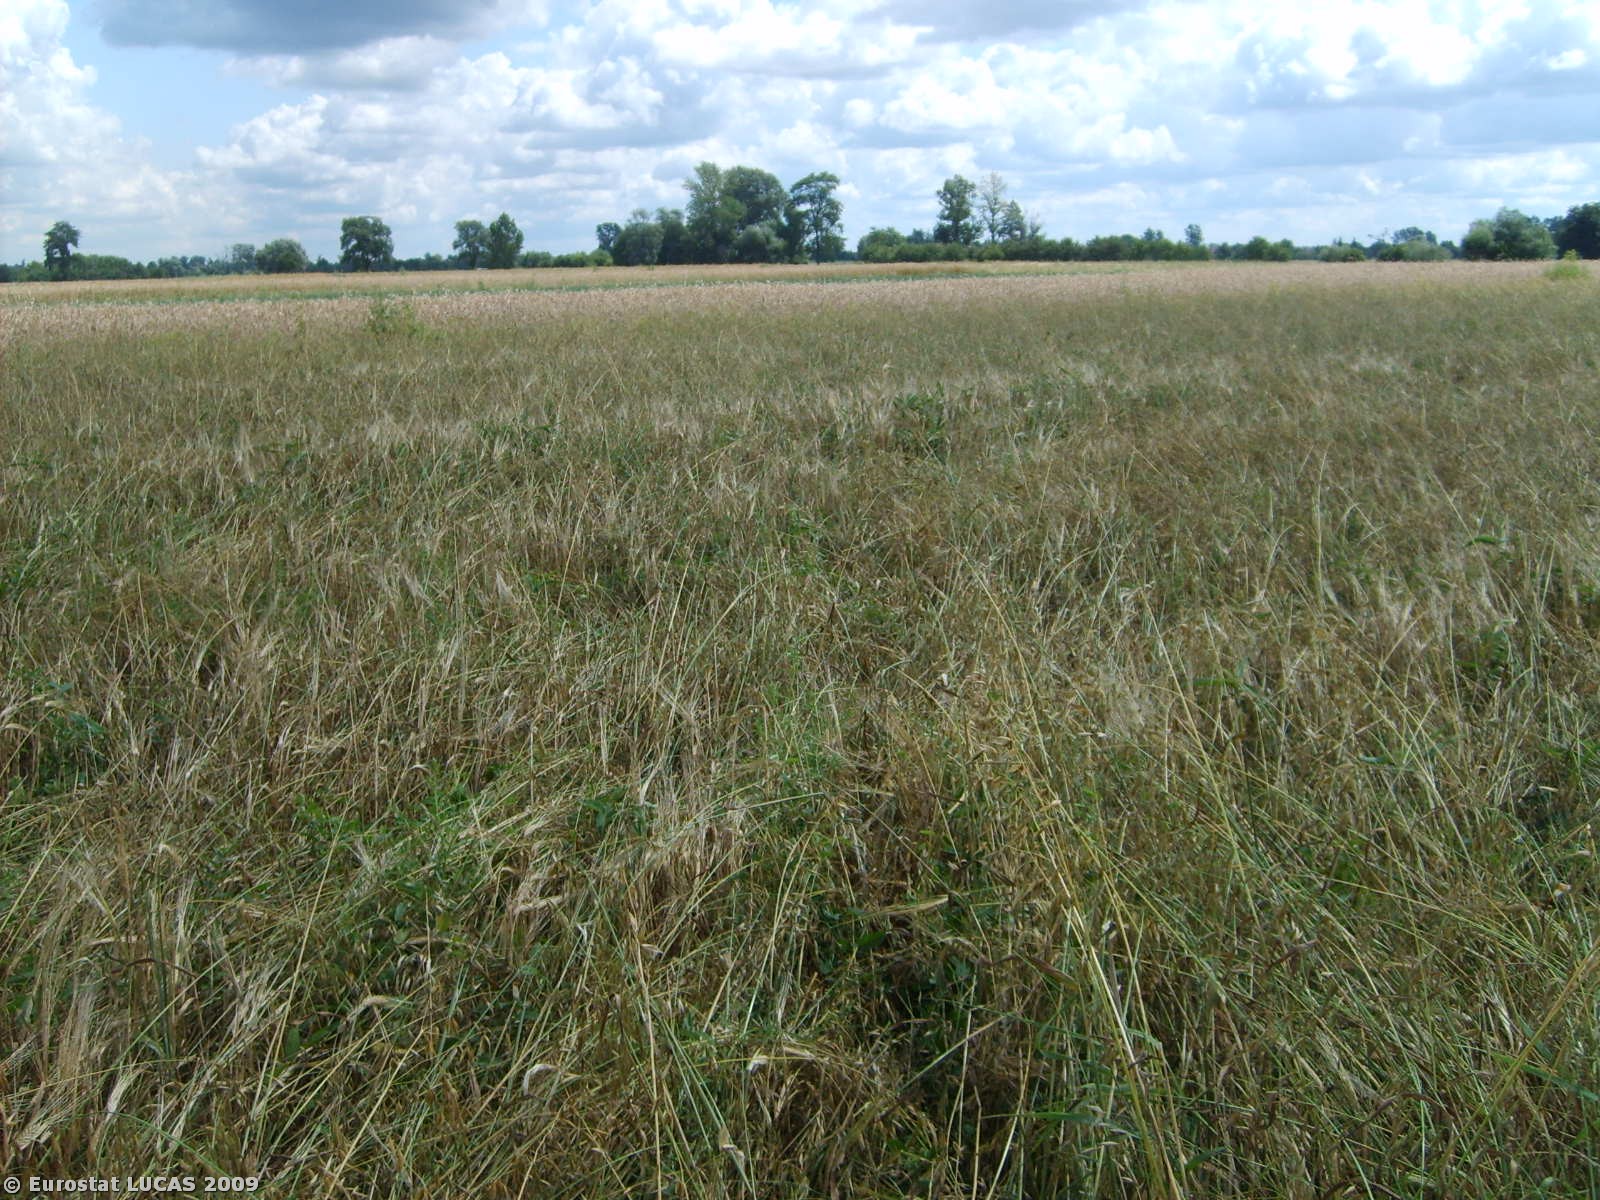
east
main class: Cropland
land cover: Mixed cereals for fodder
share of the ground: > 75 %
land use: Agriculture (excluding fallow land and kitchen gardens)
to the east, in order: Mixed cereals for fodder; Triticale; Grass margins; Grassland without tree/shrub cover; Grass margins; Other fresh vegetables; Grass margins; Tracks; Grass margins; Common wheat; Grass margins; Other fresh vegetables; Grass margins; Tracks; Grass margins; Barley; Grass margins; Potatoes; Grass margins; Tracks; Grass margins; Common wheat; Grass margins; Oats; Grass margins; Tracks; Grass margins; Other fresh vegetables
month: July
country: PL
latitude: 51.6516
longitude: 21.5131
